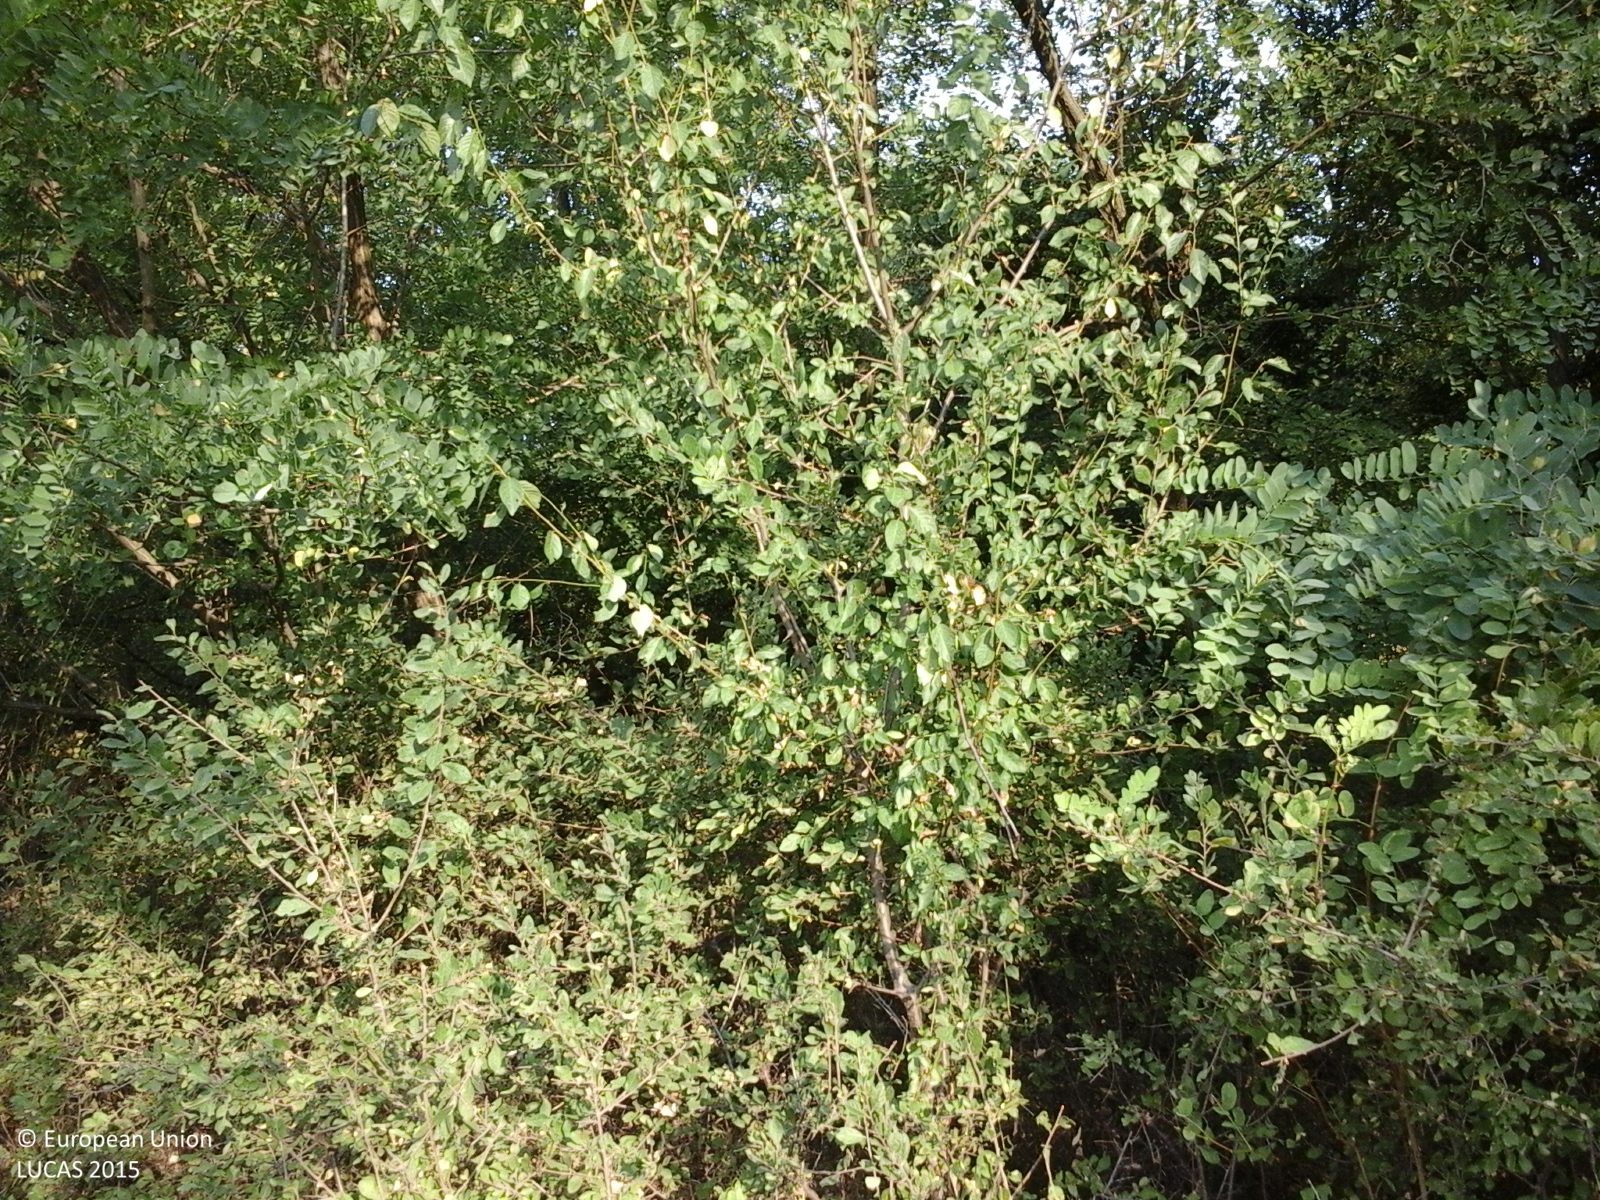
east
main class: Shrubland
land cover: Shrubland with sparse tree cover
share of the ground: > 75 %
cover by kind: shrubs 95 %, broadleaved forest trees 5 %
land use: Semi-natural and natural areas not in use
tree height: < 5 m
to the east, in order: Shrubland with sparse tree cover; Broadleaved woodland; Spontaneously vegetated surfaces
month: August
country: RO
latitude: 44.4196
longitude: 23.4531
